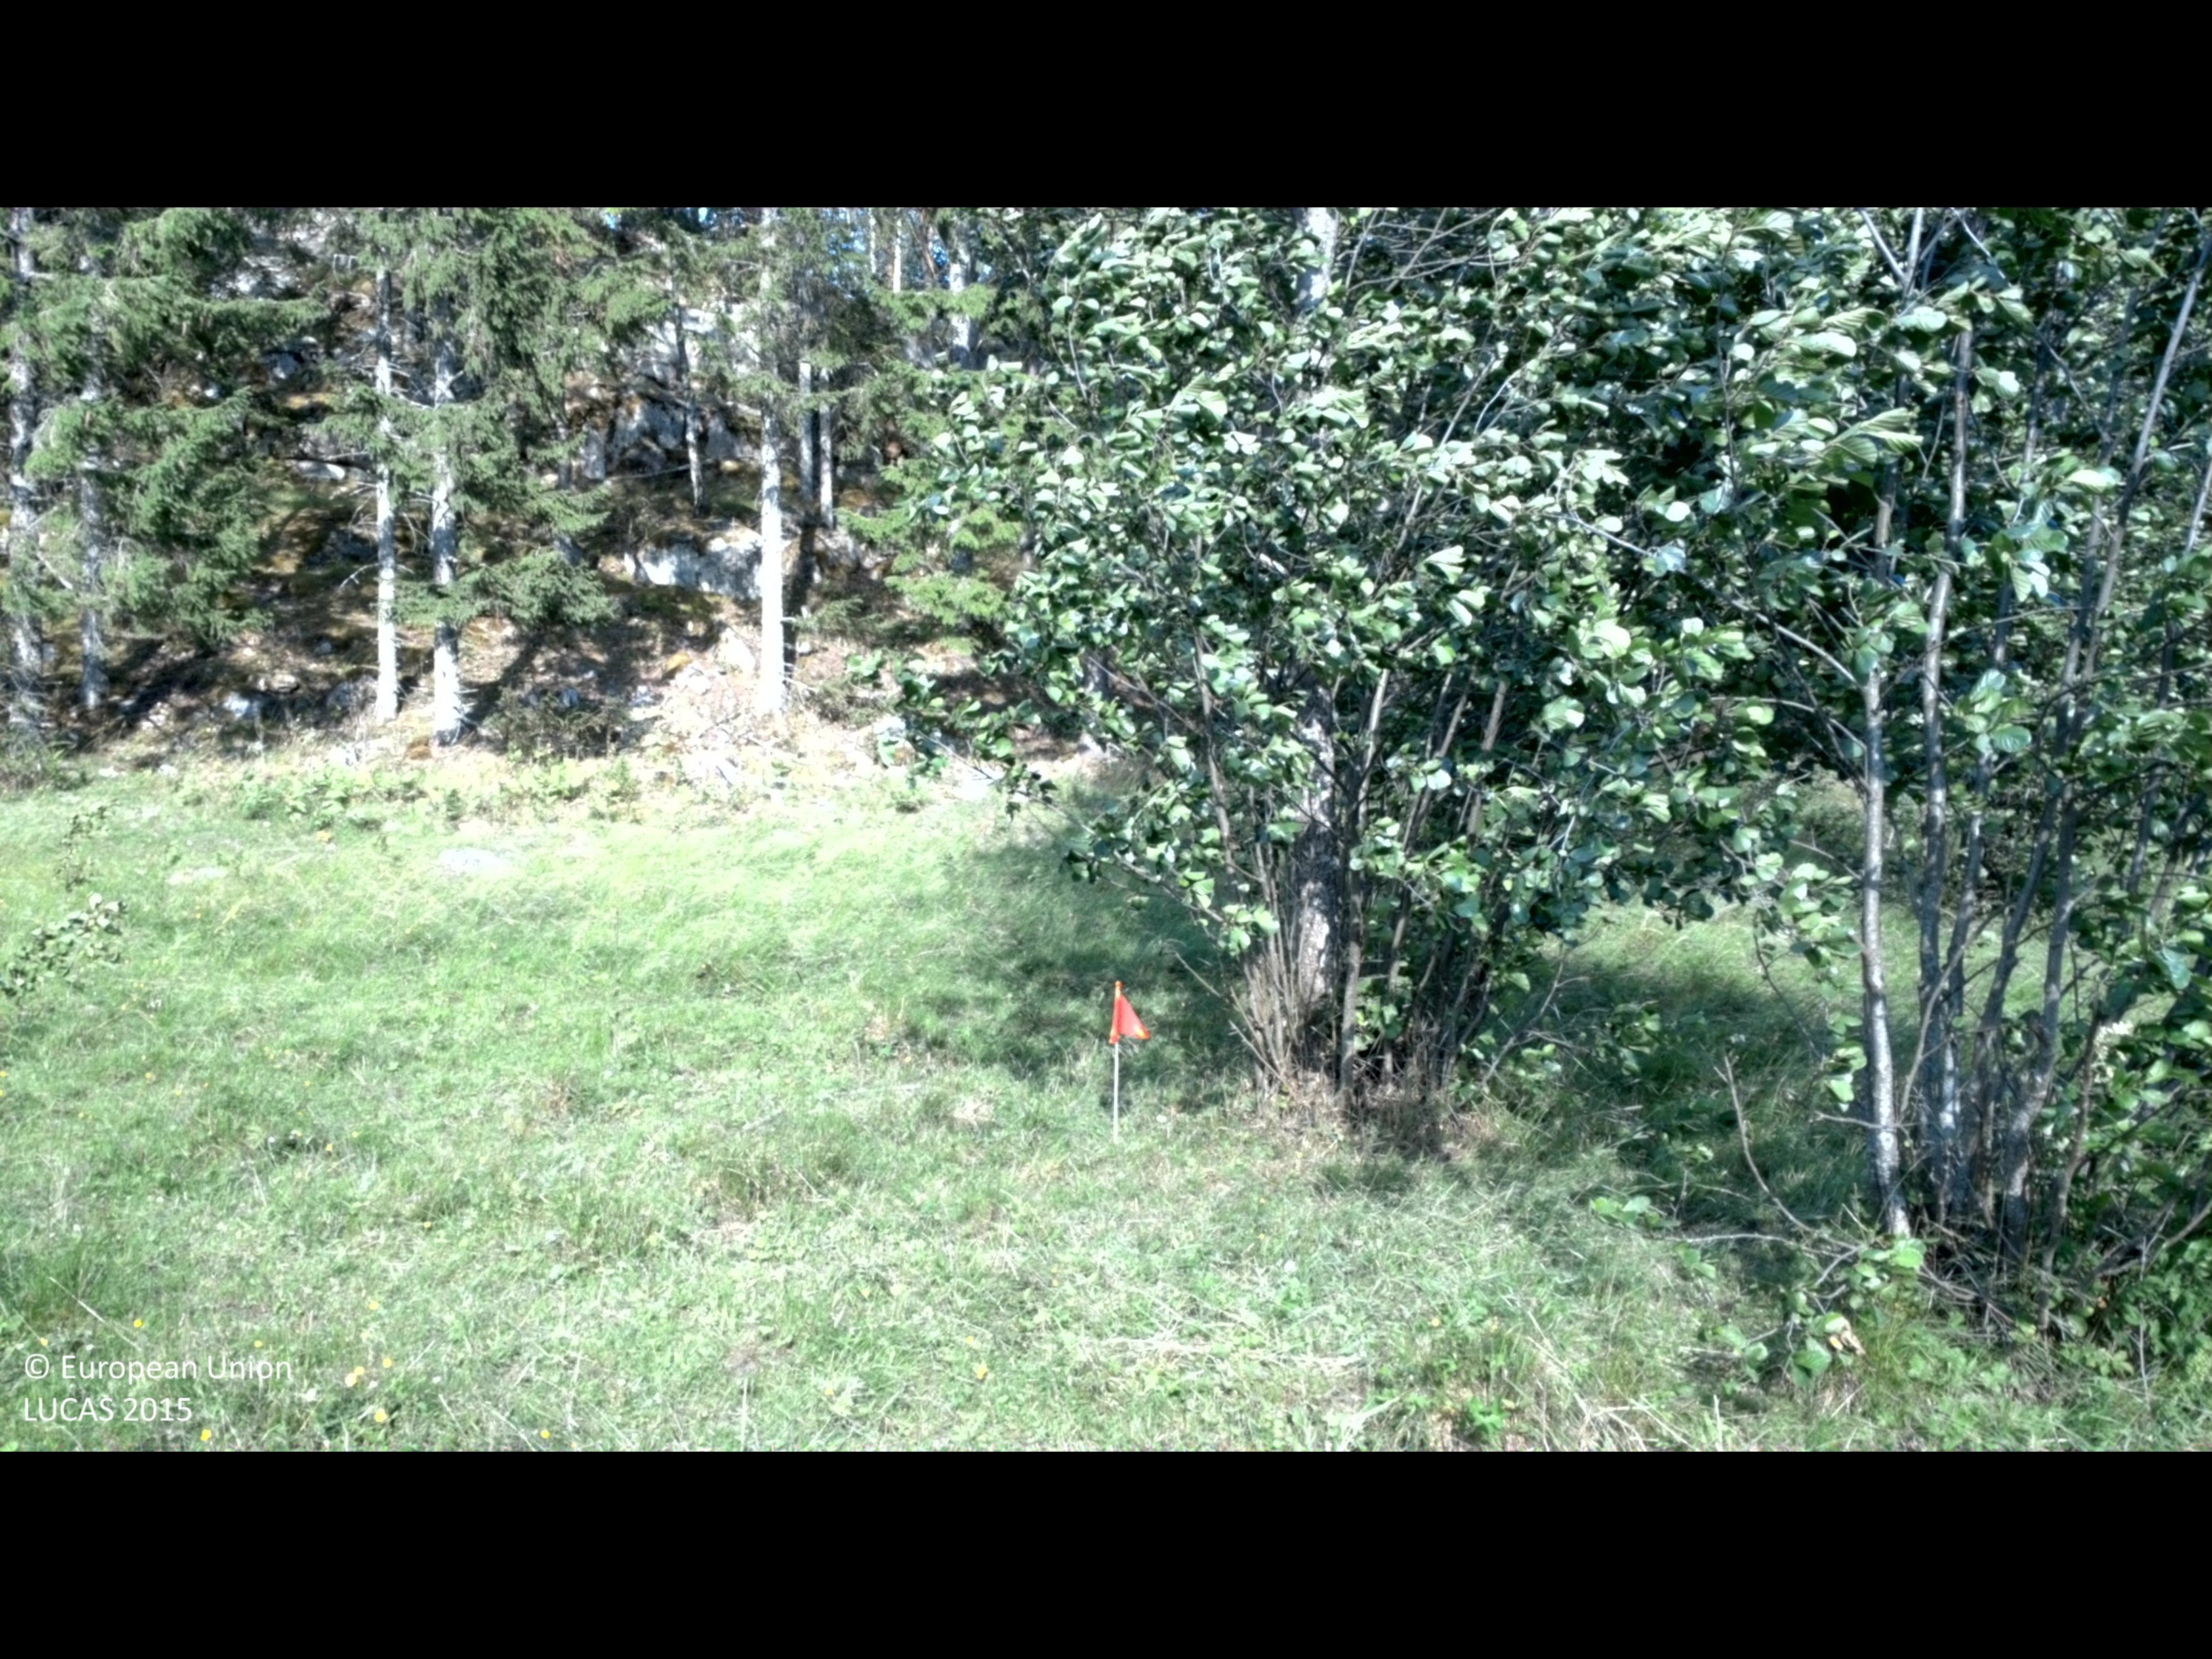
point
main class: Grassland
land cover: Grassland with sparse tree/shrub cover
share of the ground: > 75 %
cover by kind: herbaceous plants 85 %, shrubs 10 %, broadleaved forest trees 5 %
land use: Agriculture (excluding fallow land and kitchen gardens)
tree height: > 5 m
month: July
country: SE
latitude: 58.3378
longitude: 16.4016
